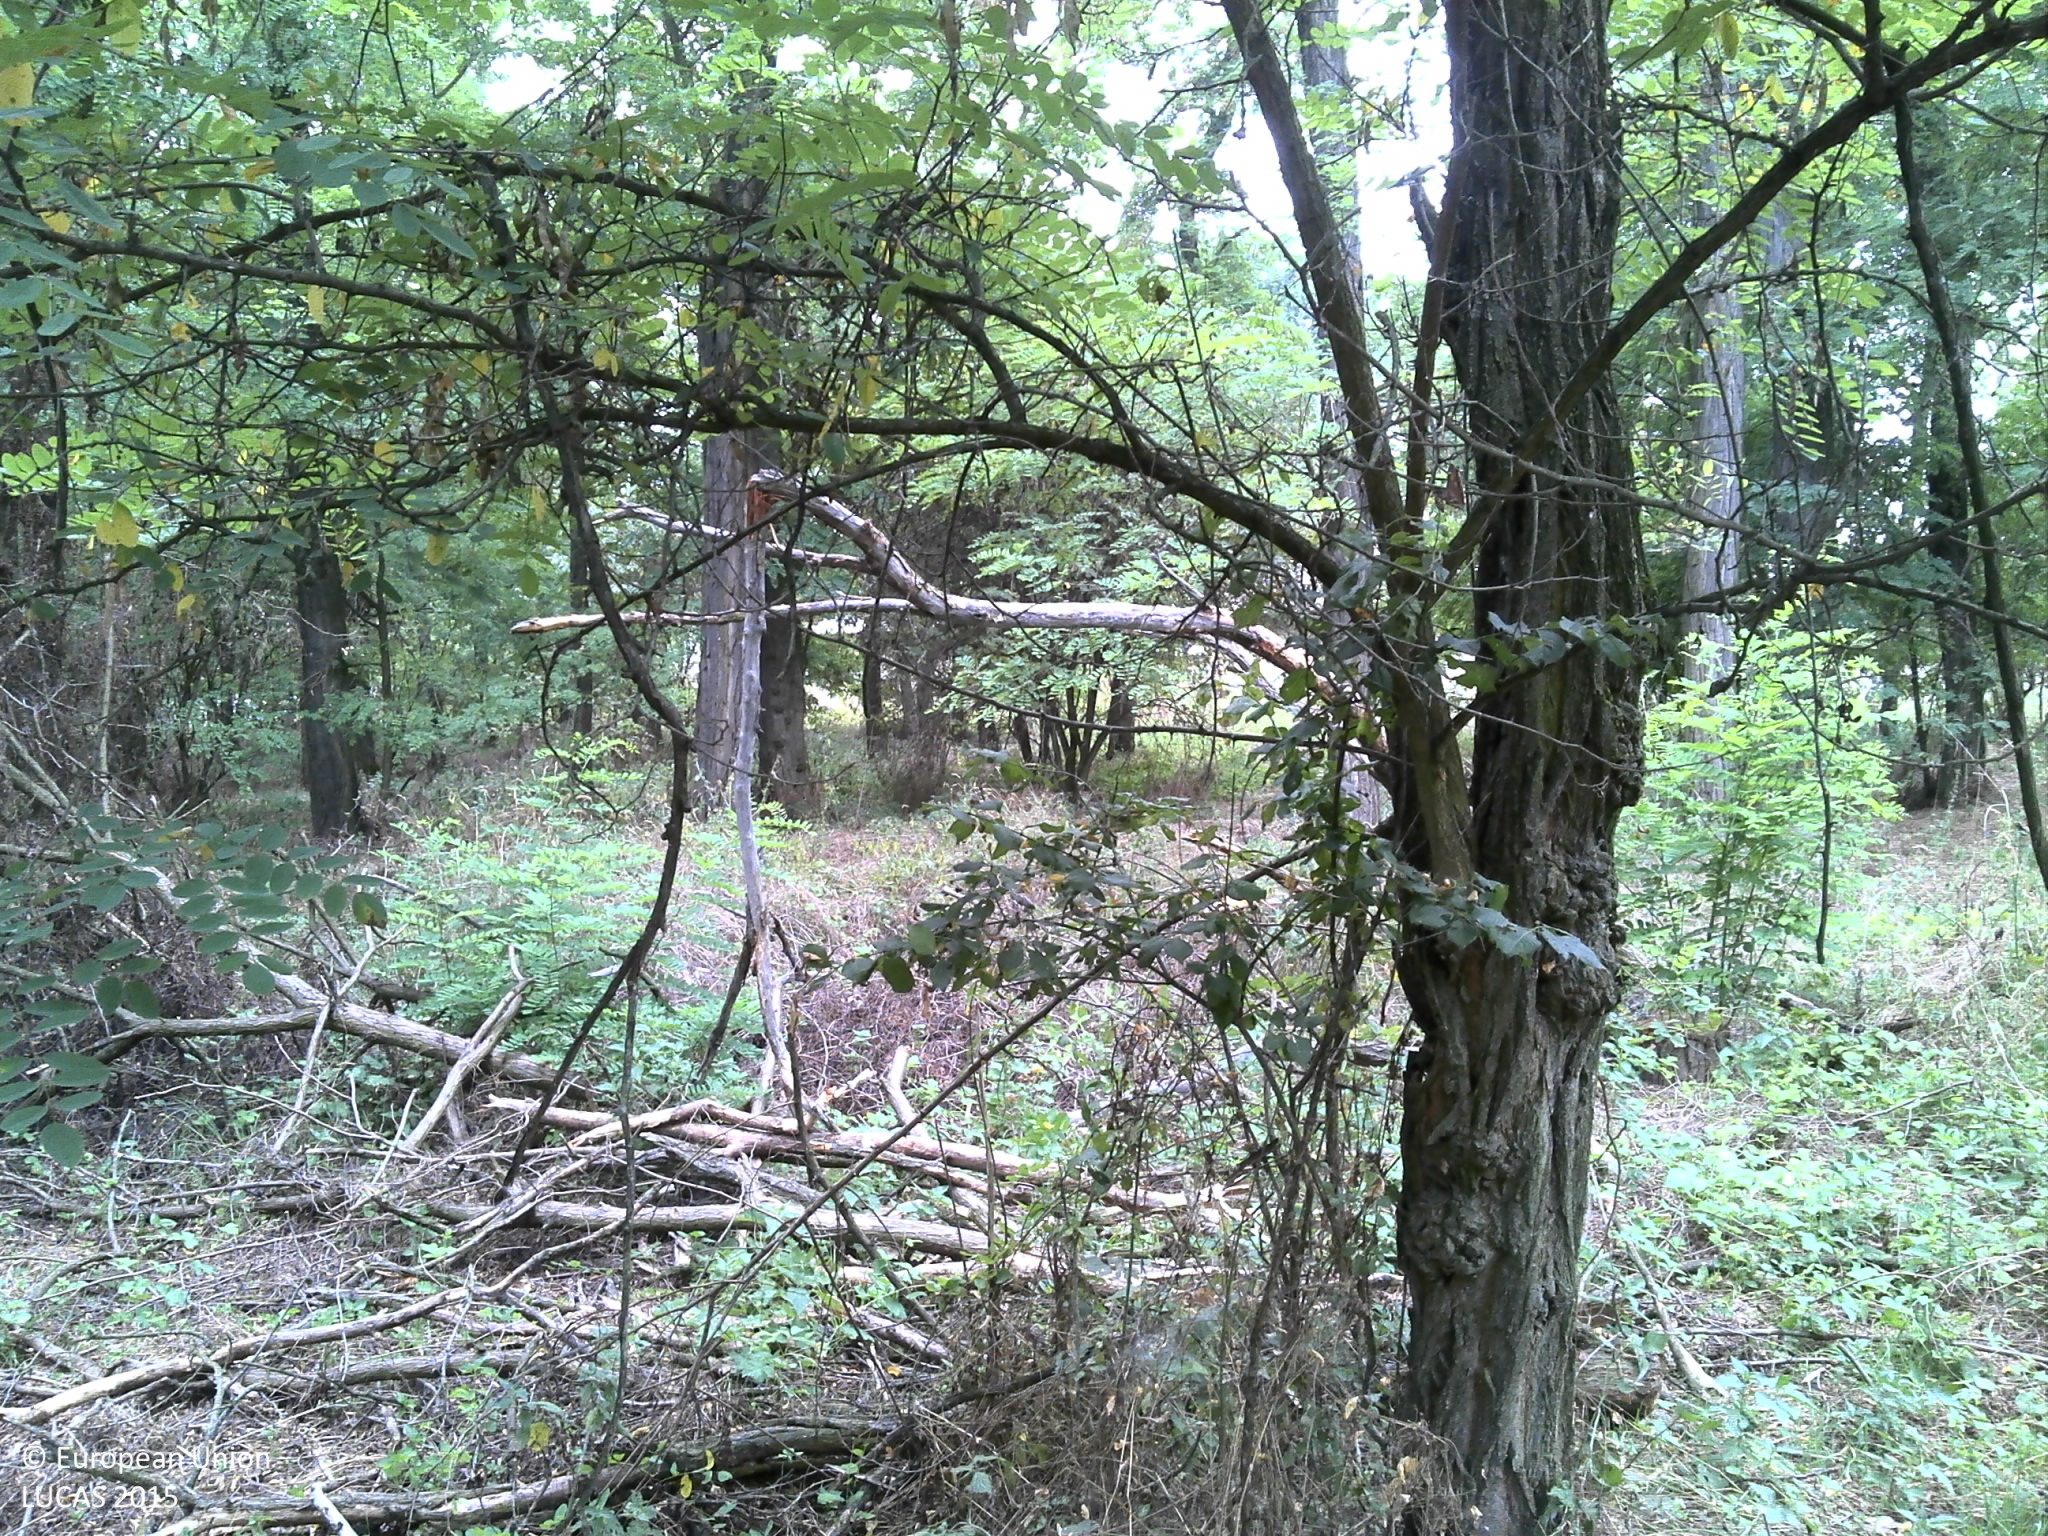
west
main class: Woodland
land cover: Broadleaved woodland
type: acidophilous oak and oak-birch forest
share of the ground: > 75 %
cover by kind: herbaceous plants 55 %, broadleaved forest trees 45 %
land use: Forestry
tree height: > 5 m
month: August
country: HR
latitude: 45.5156
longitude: 18.5966
